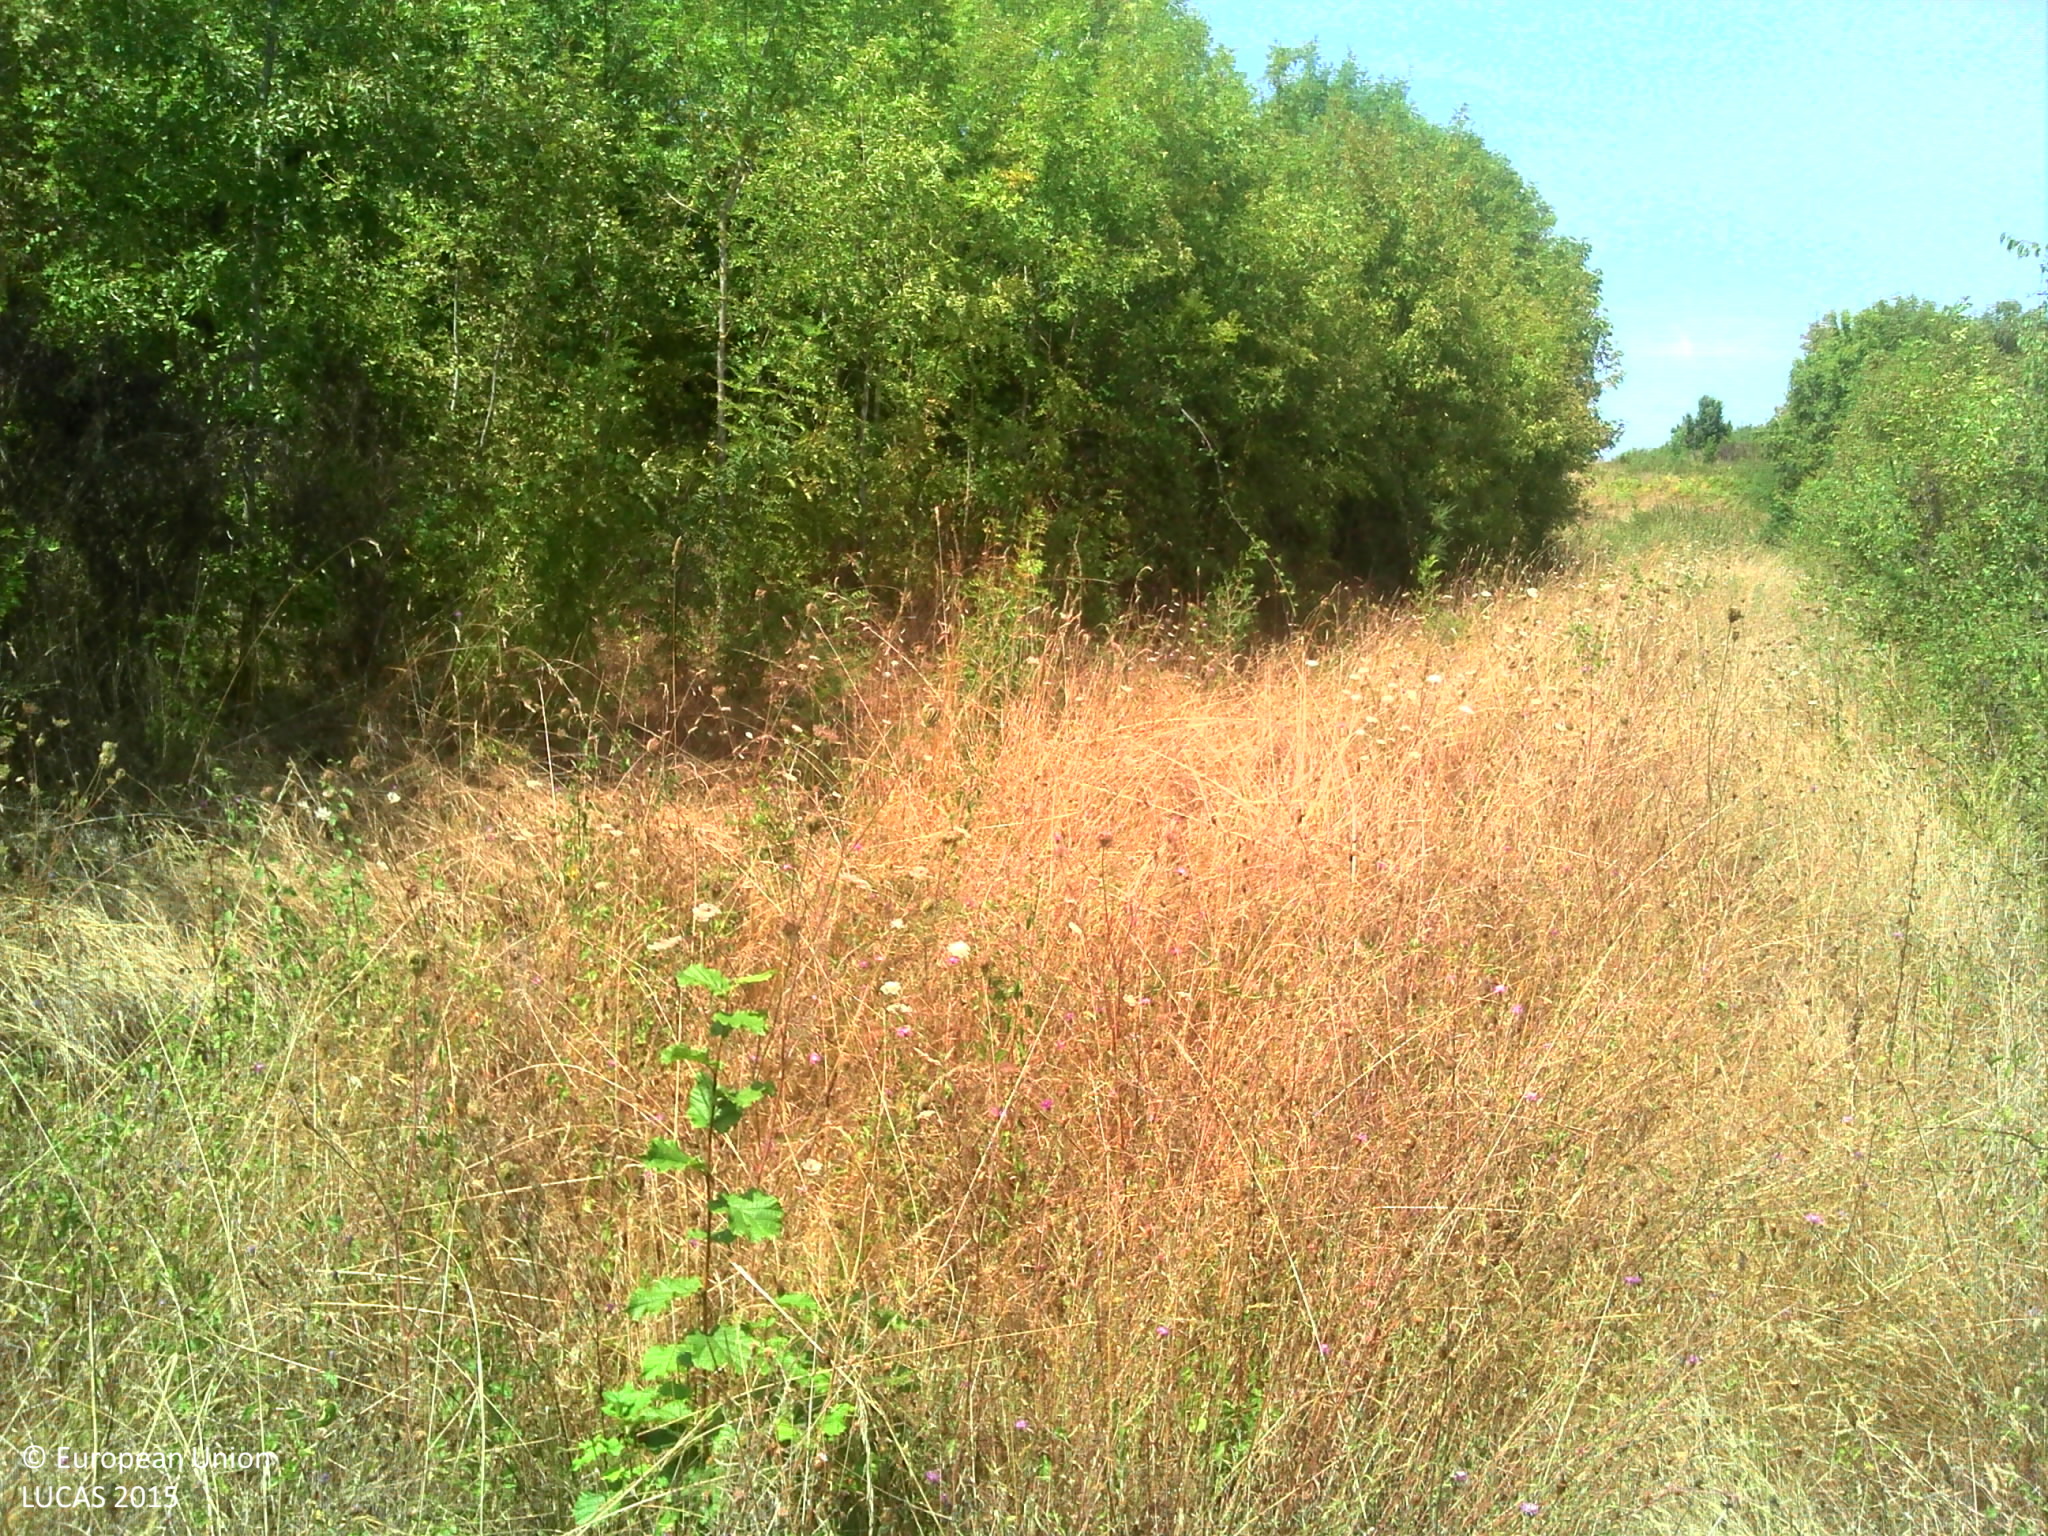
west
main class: Woodland
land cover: Broadleaved woodland
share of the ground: > 75 %
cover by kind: broadleaved forest trees 90 %, shrubs 10 %
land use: Road transport
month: August
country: FR
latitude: 46.6563
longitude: -1.1551
